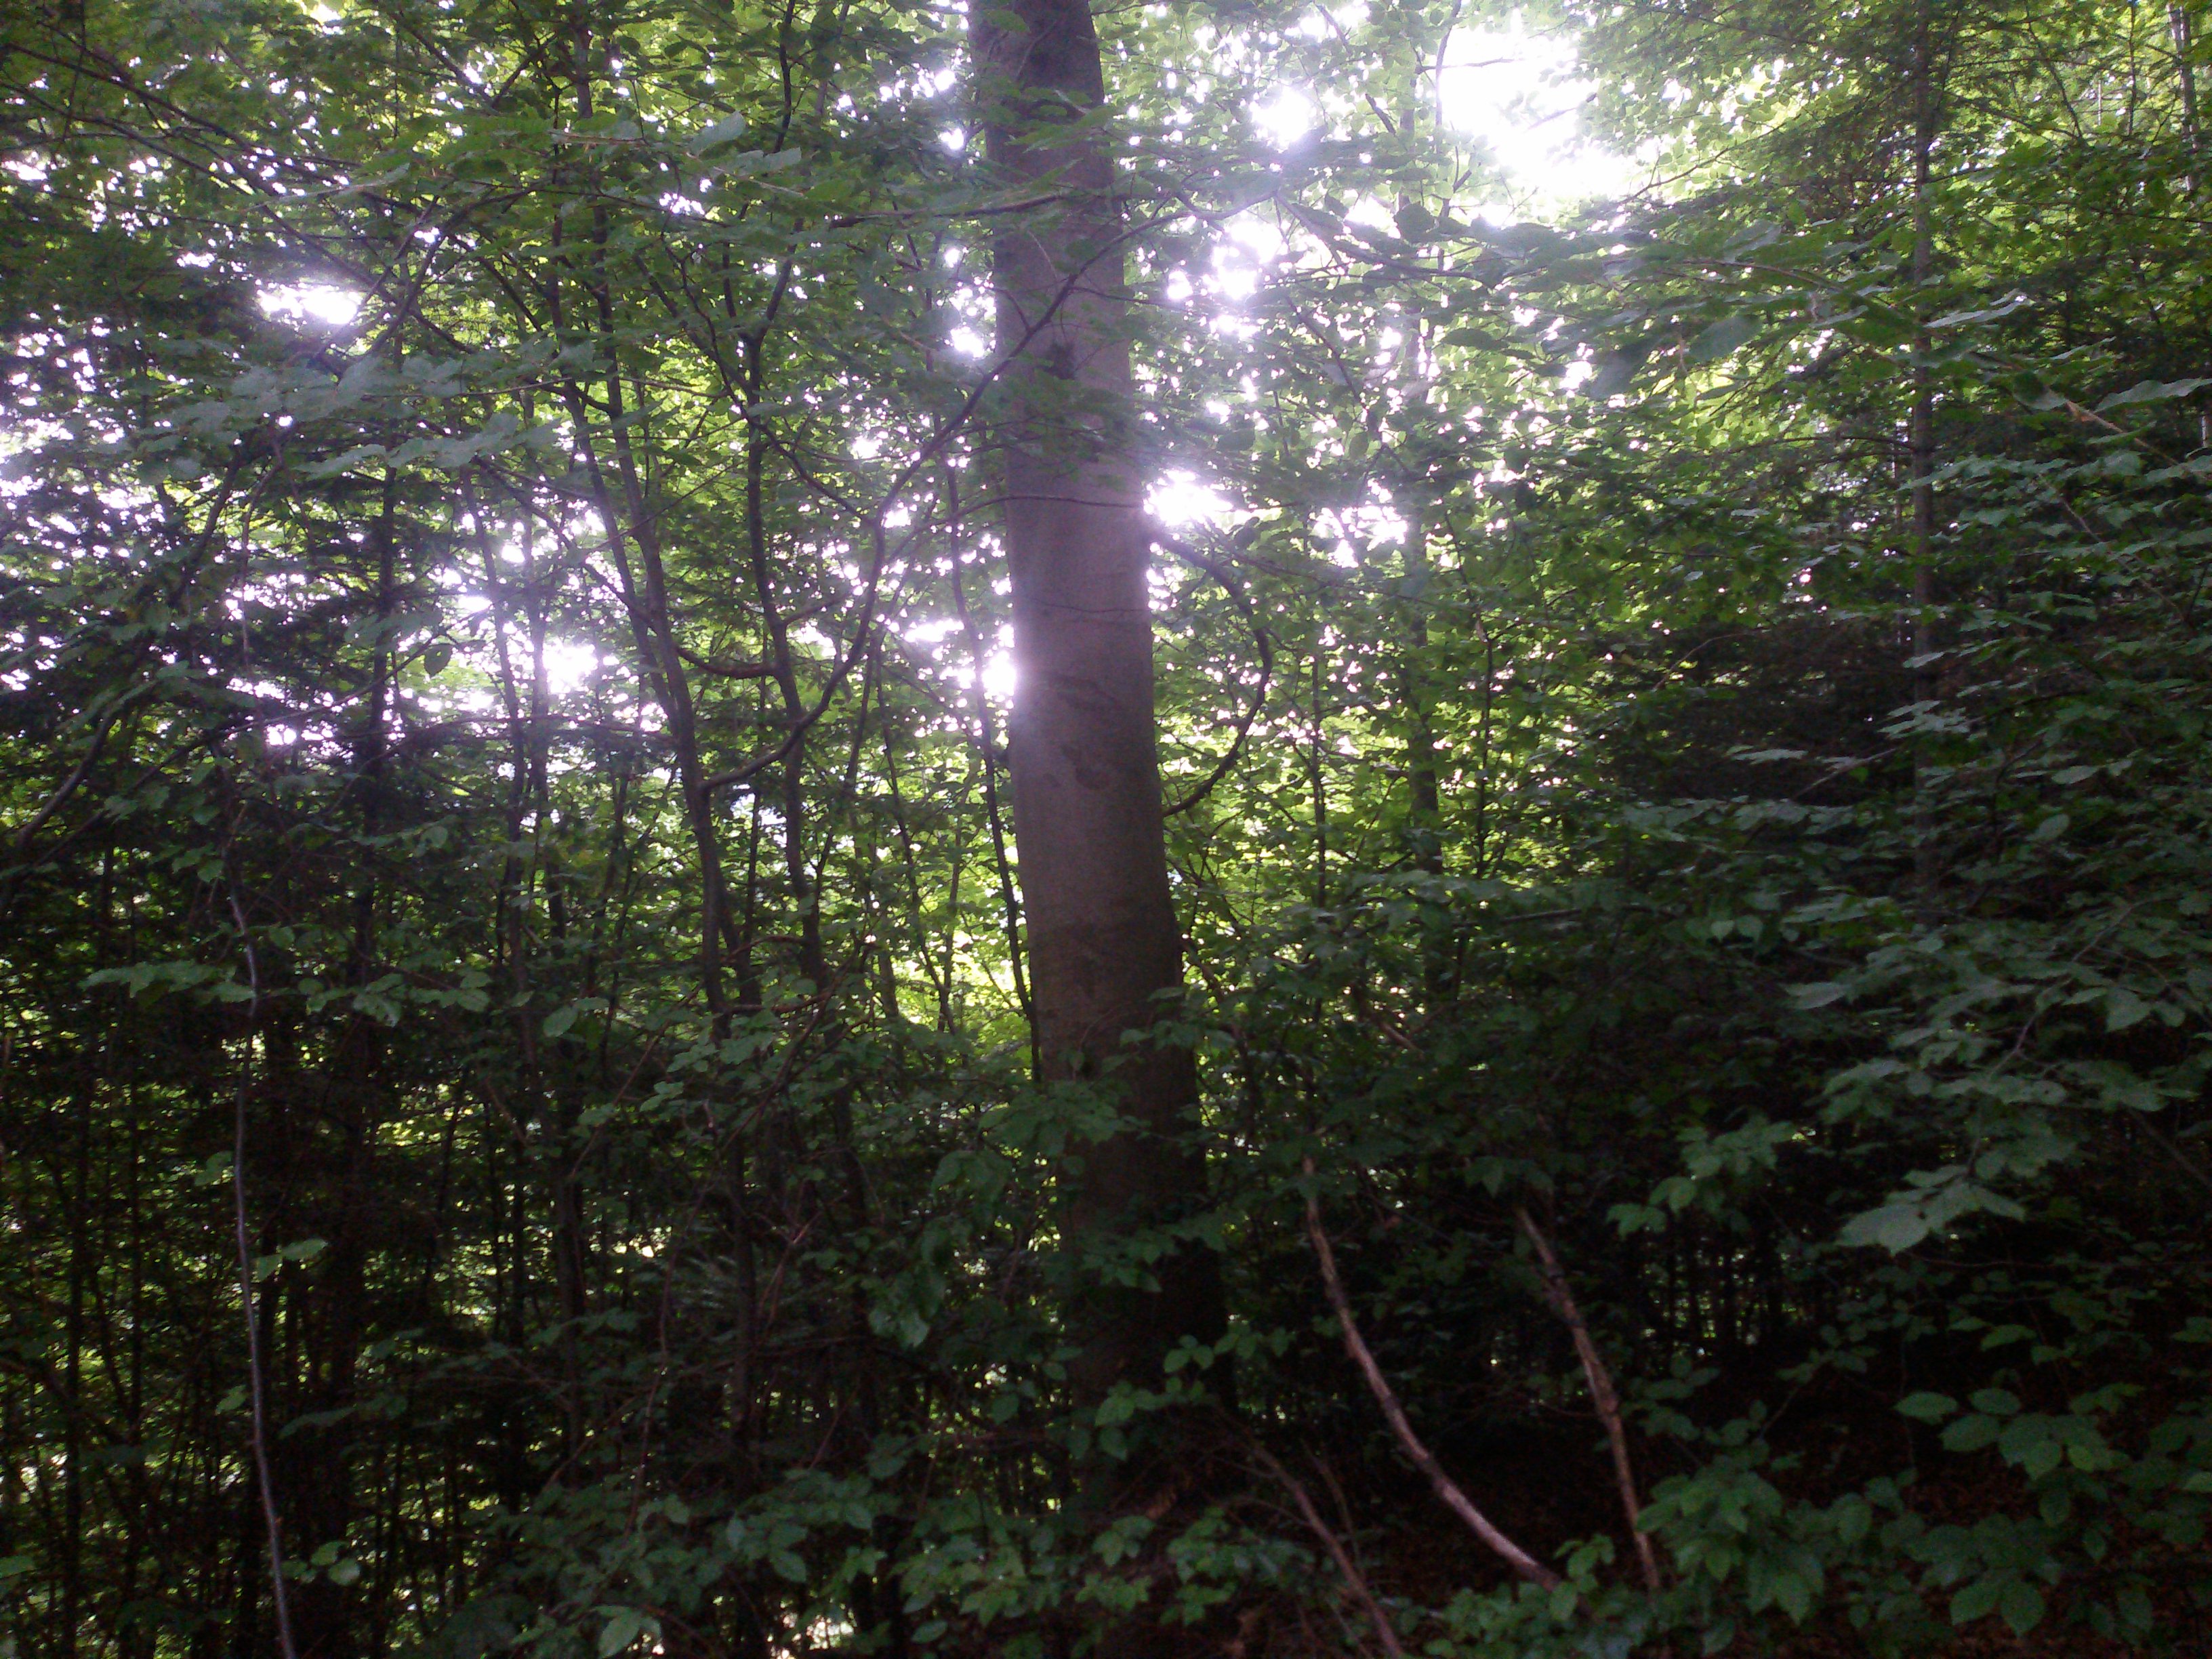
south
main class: Woodland
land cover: Other mixed woodland
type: hemiboreal forest and nemoral coniferous forest and mixed broadleaved-coniferous forest
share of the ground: > 75 %
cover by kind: broadleaved forest trees 50 %, coniferous forest trees 30 %, unconsolidated bare surface 10 %, shrubs 5 %, herbaceous plants 5 %
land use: Forestry
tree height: > 5 m
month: July
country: PL
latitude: 49.7381
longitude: 22.2576
